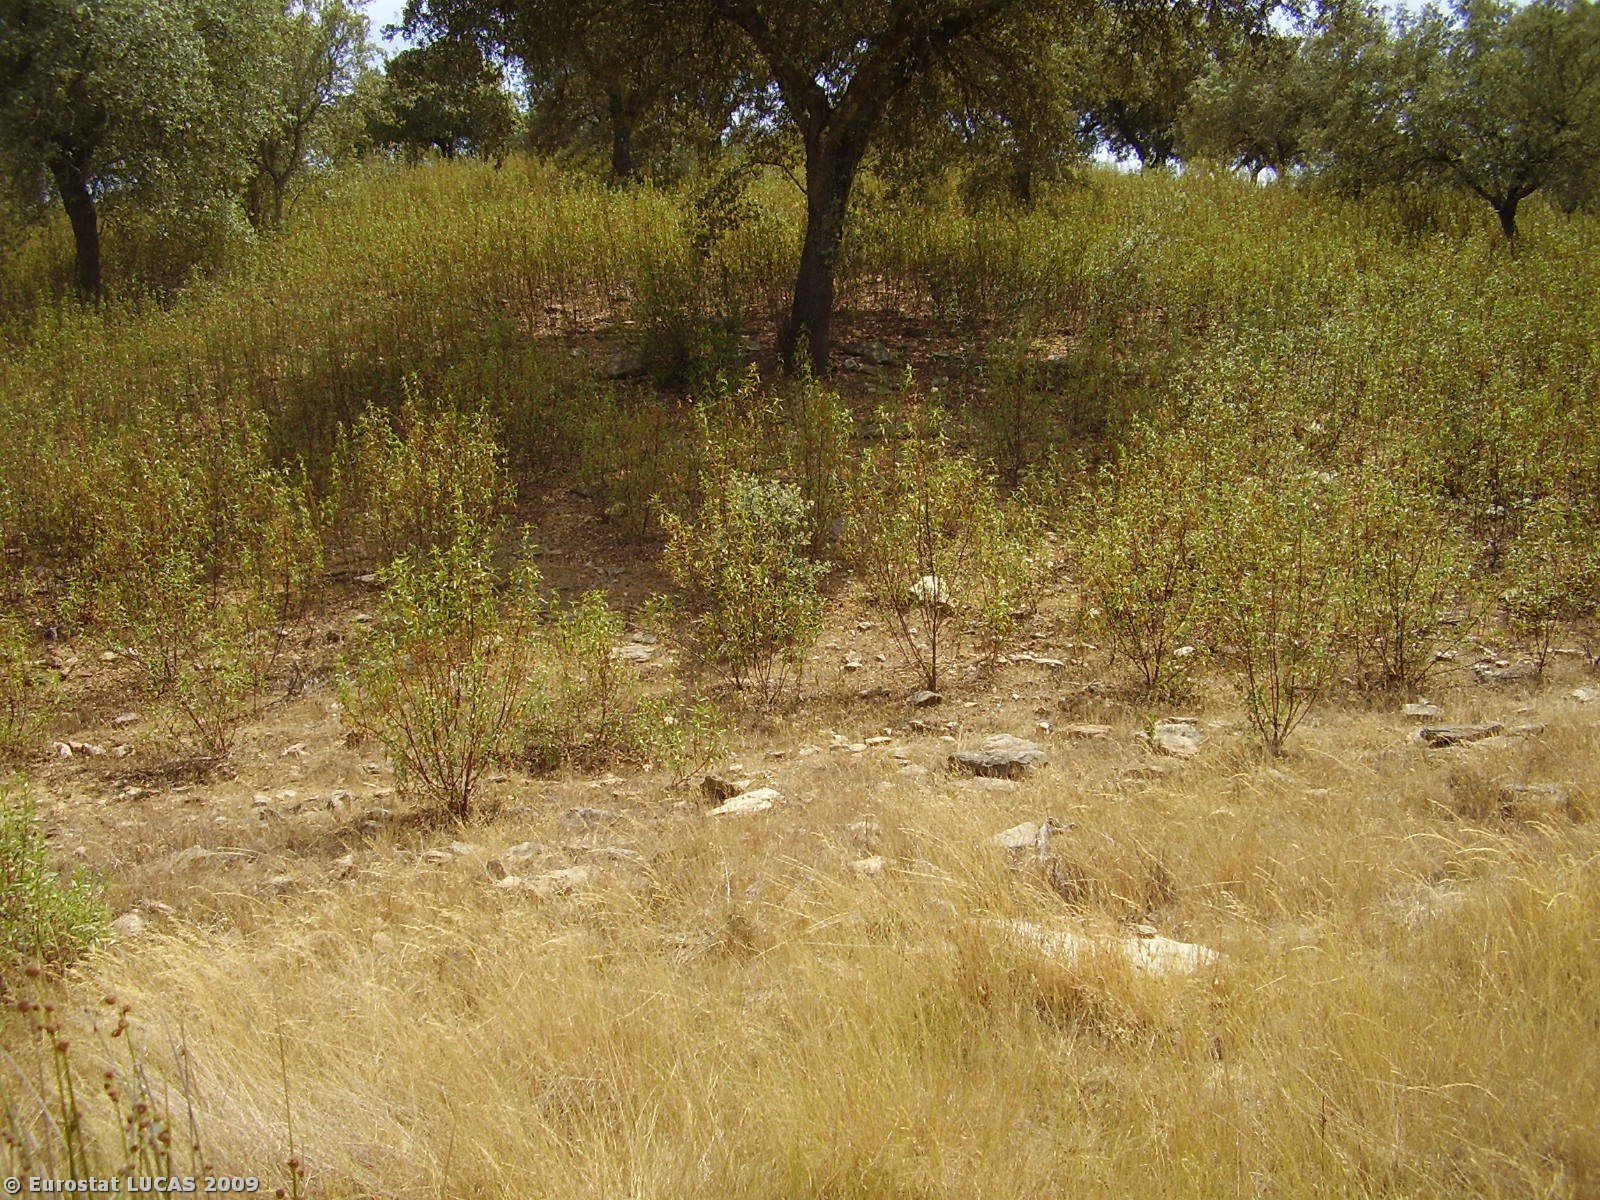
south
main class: Grassland
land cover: Grassland with sparse tree/shrub cover
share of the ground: > 75 %
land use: Forestry
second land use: Agriculture (excluding fallow land and kitchen gardens)
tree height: > 5 m
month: July
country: PT
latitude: 38.5665
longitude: -7.8150
